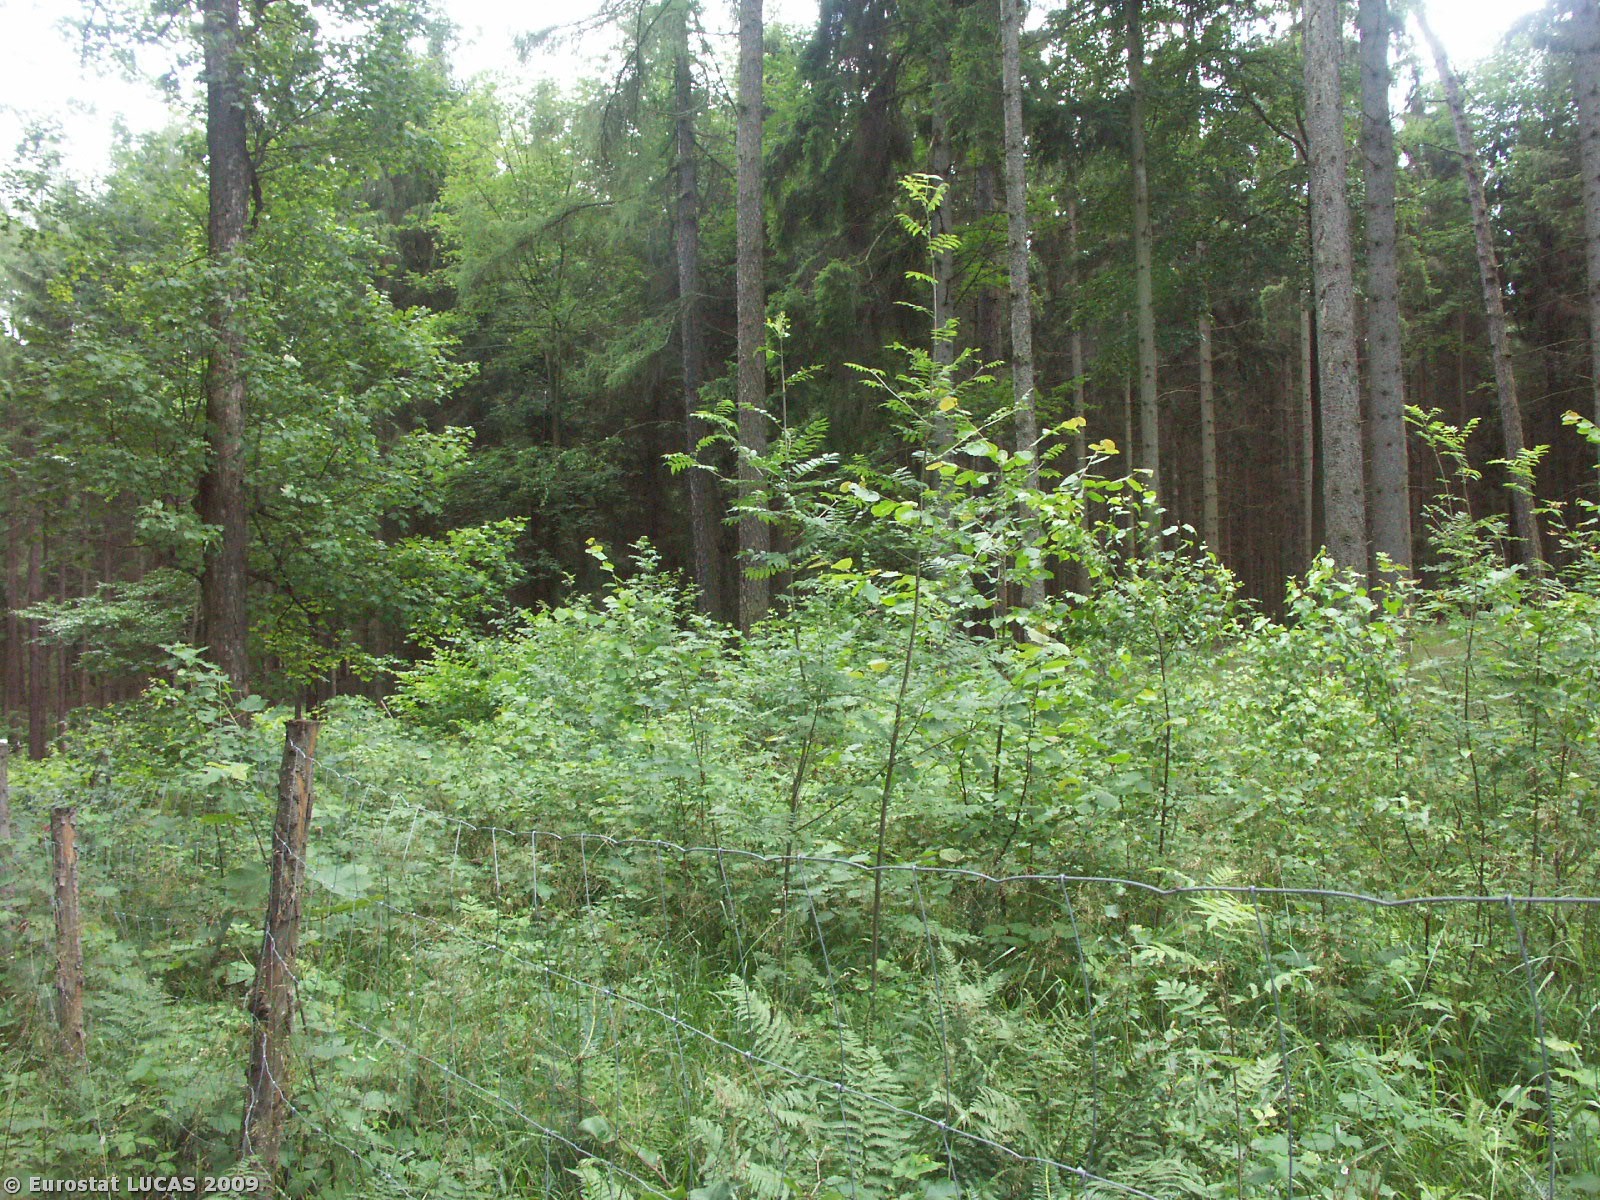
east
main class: Woodland
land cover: Mixed woodland
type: hemiboreal forest and nemoral coniferous forest and mixed broadleaved-coniferous forest
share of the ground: > 75 %
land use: Forestry
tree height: > 5 m
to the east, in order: Mixed woodland; Fences; Mixed woodland; Fences; Mixed woodland; Coniferous woodland; Tracks; Coniferous woodland; Paved roads, cycling and walking lanes; Ditches and canals; Coniferous woodland; Tracks; Coniferous woodland; Mixed woodland; Coniferous woodland
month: July
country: CZ
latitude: 49.8586
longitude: 17.5939
